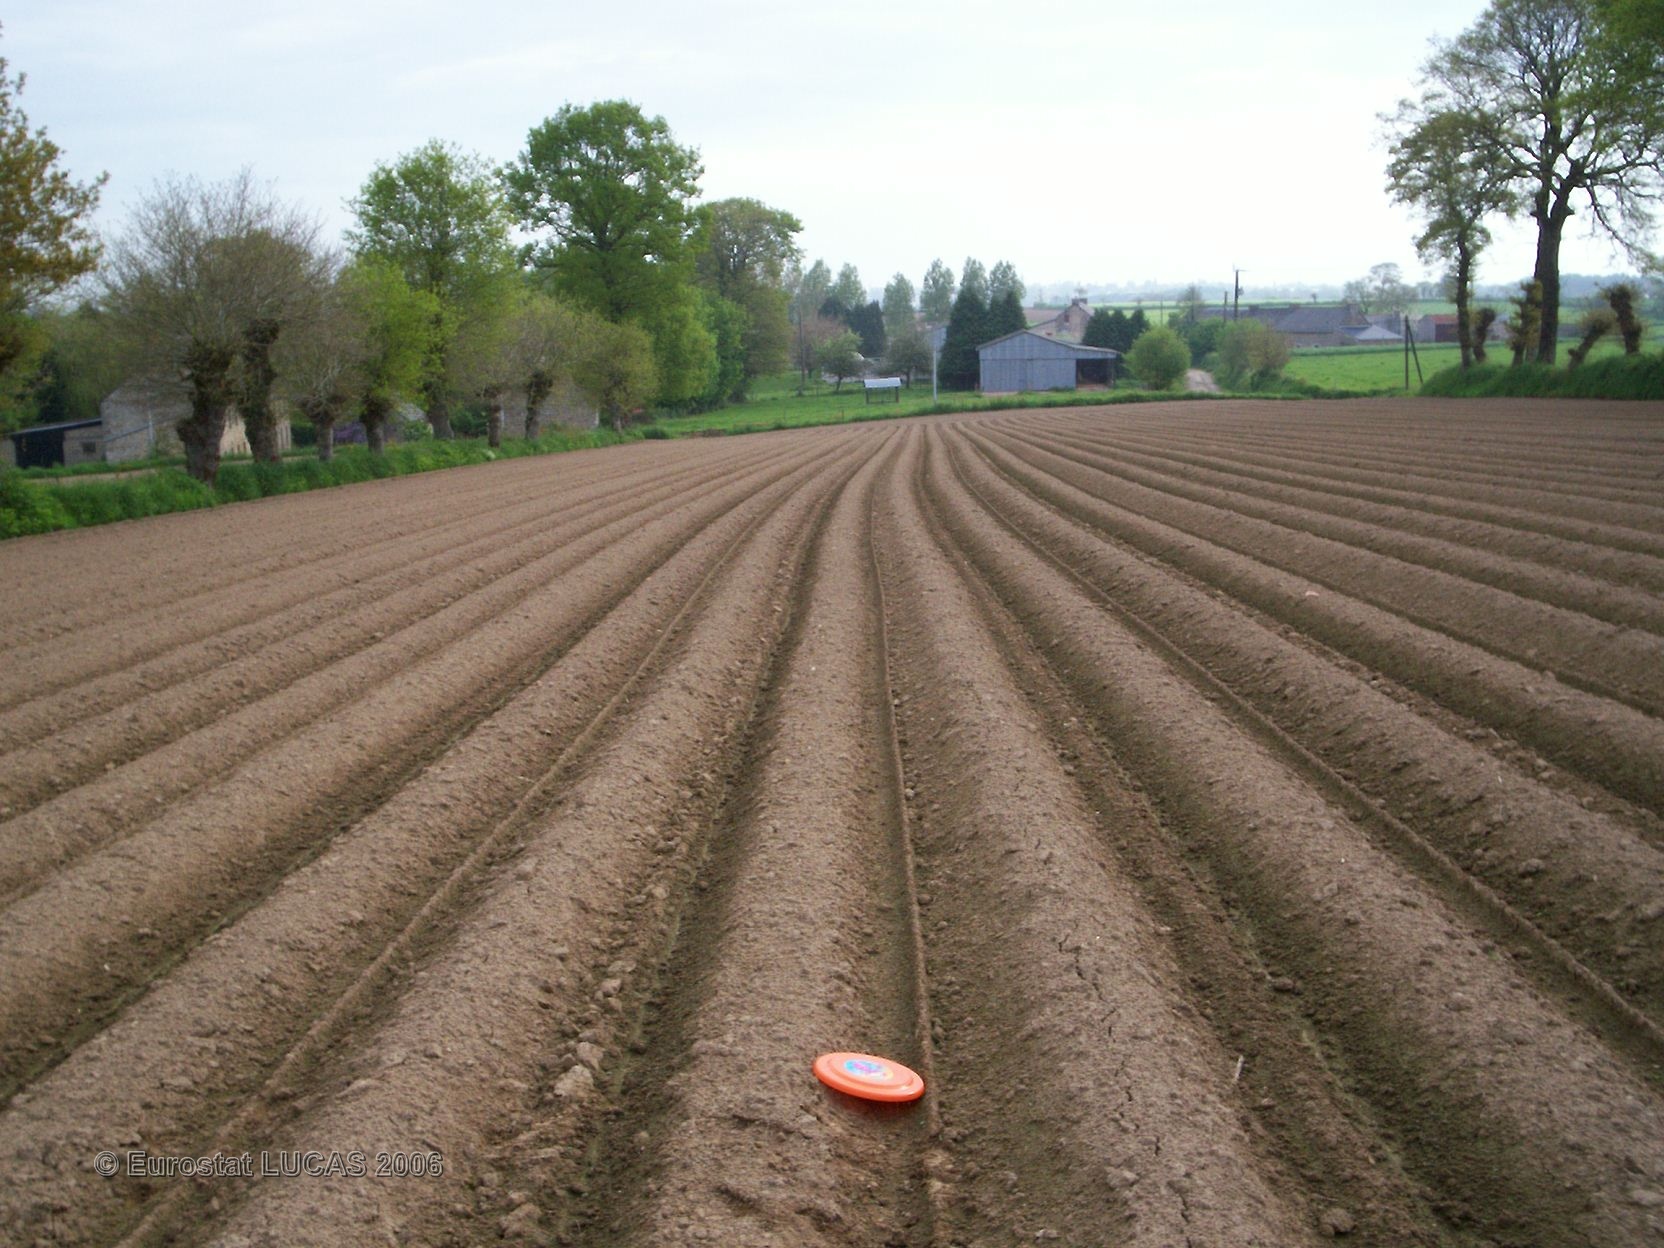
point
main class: Cropland
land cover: Potatoes
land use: Agriculture (excluding fallow land and kitchen gardens)
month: June
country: FR
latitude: 48.3315
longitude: -2.7859
